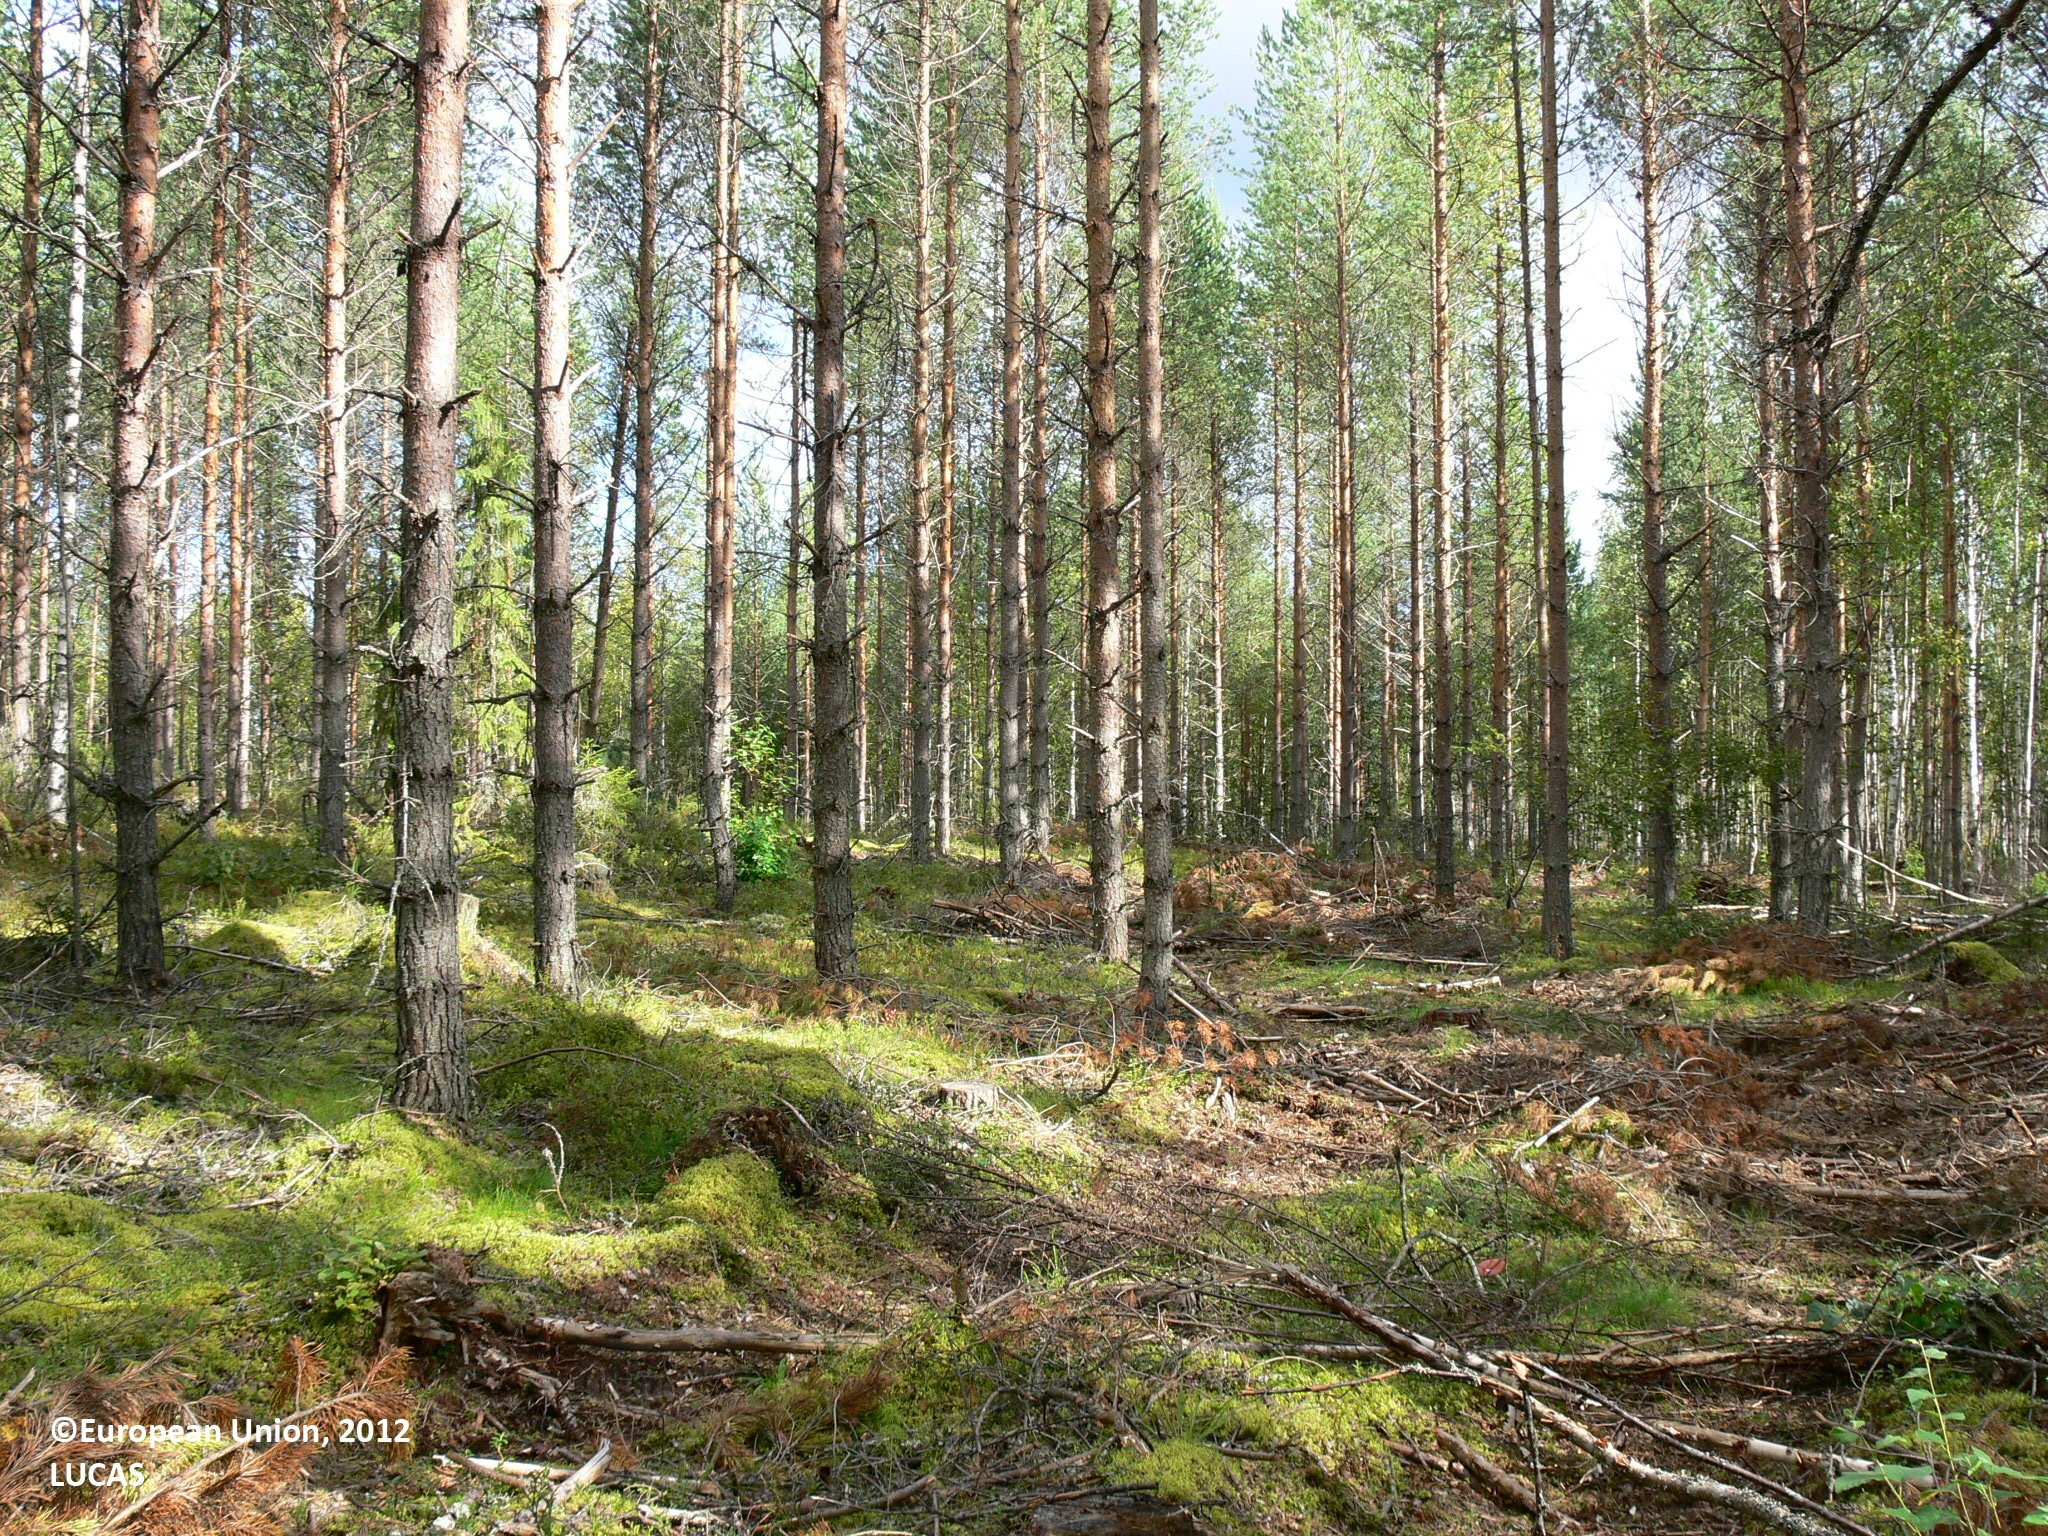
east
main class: Woodland
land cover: Pine dominated mixed woodland
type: boreal forest
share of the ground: 50 - 75 %
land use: Forestry
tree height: > 5 m
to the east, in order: Pine dominated mixed woodland; Pine dominated coniferous woodland; Ditches and canals; Pine dominated mixed woodland; Ditches and canals; Pine dominated coniferous woodland; Ditches and canals; Pine dominated coniferous woodland
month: August
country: FI
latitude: 63.3255
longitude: 30.2888
